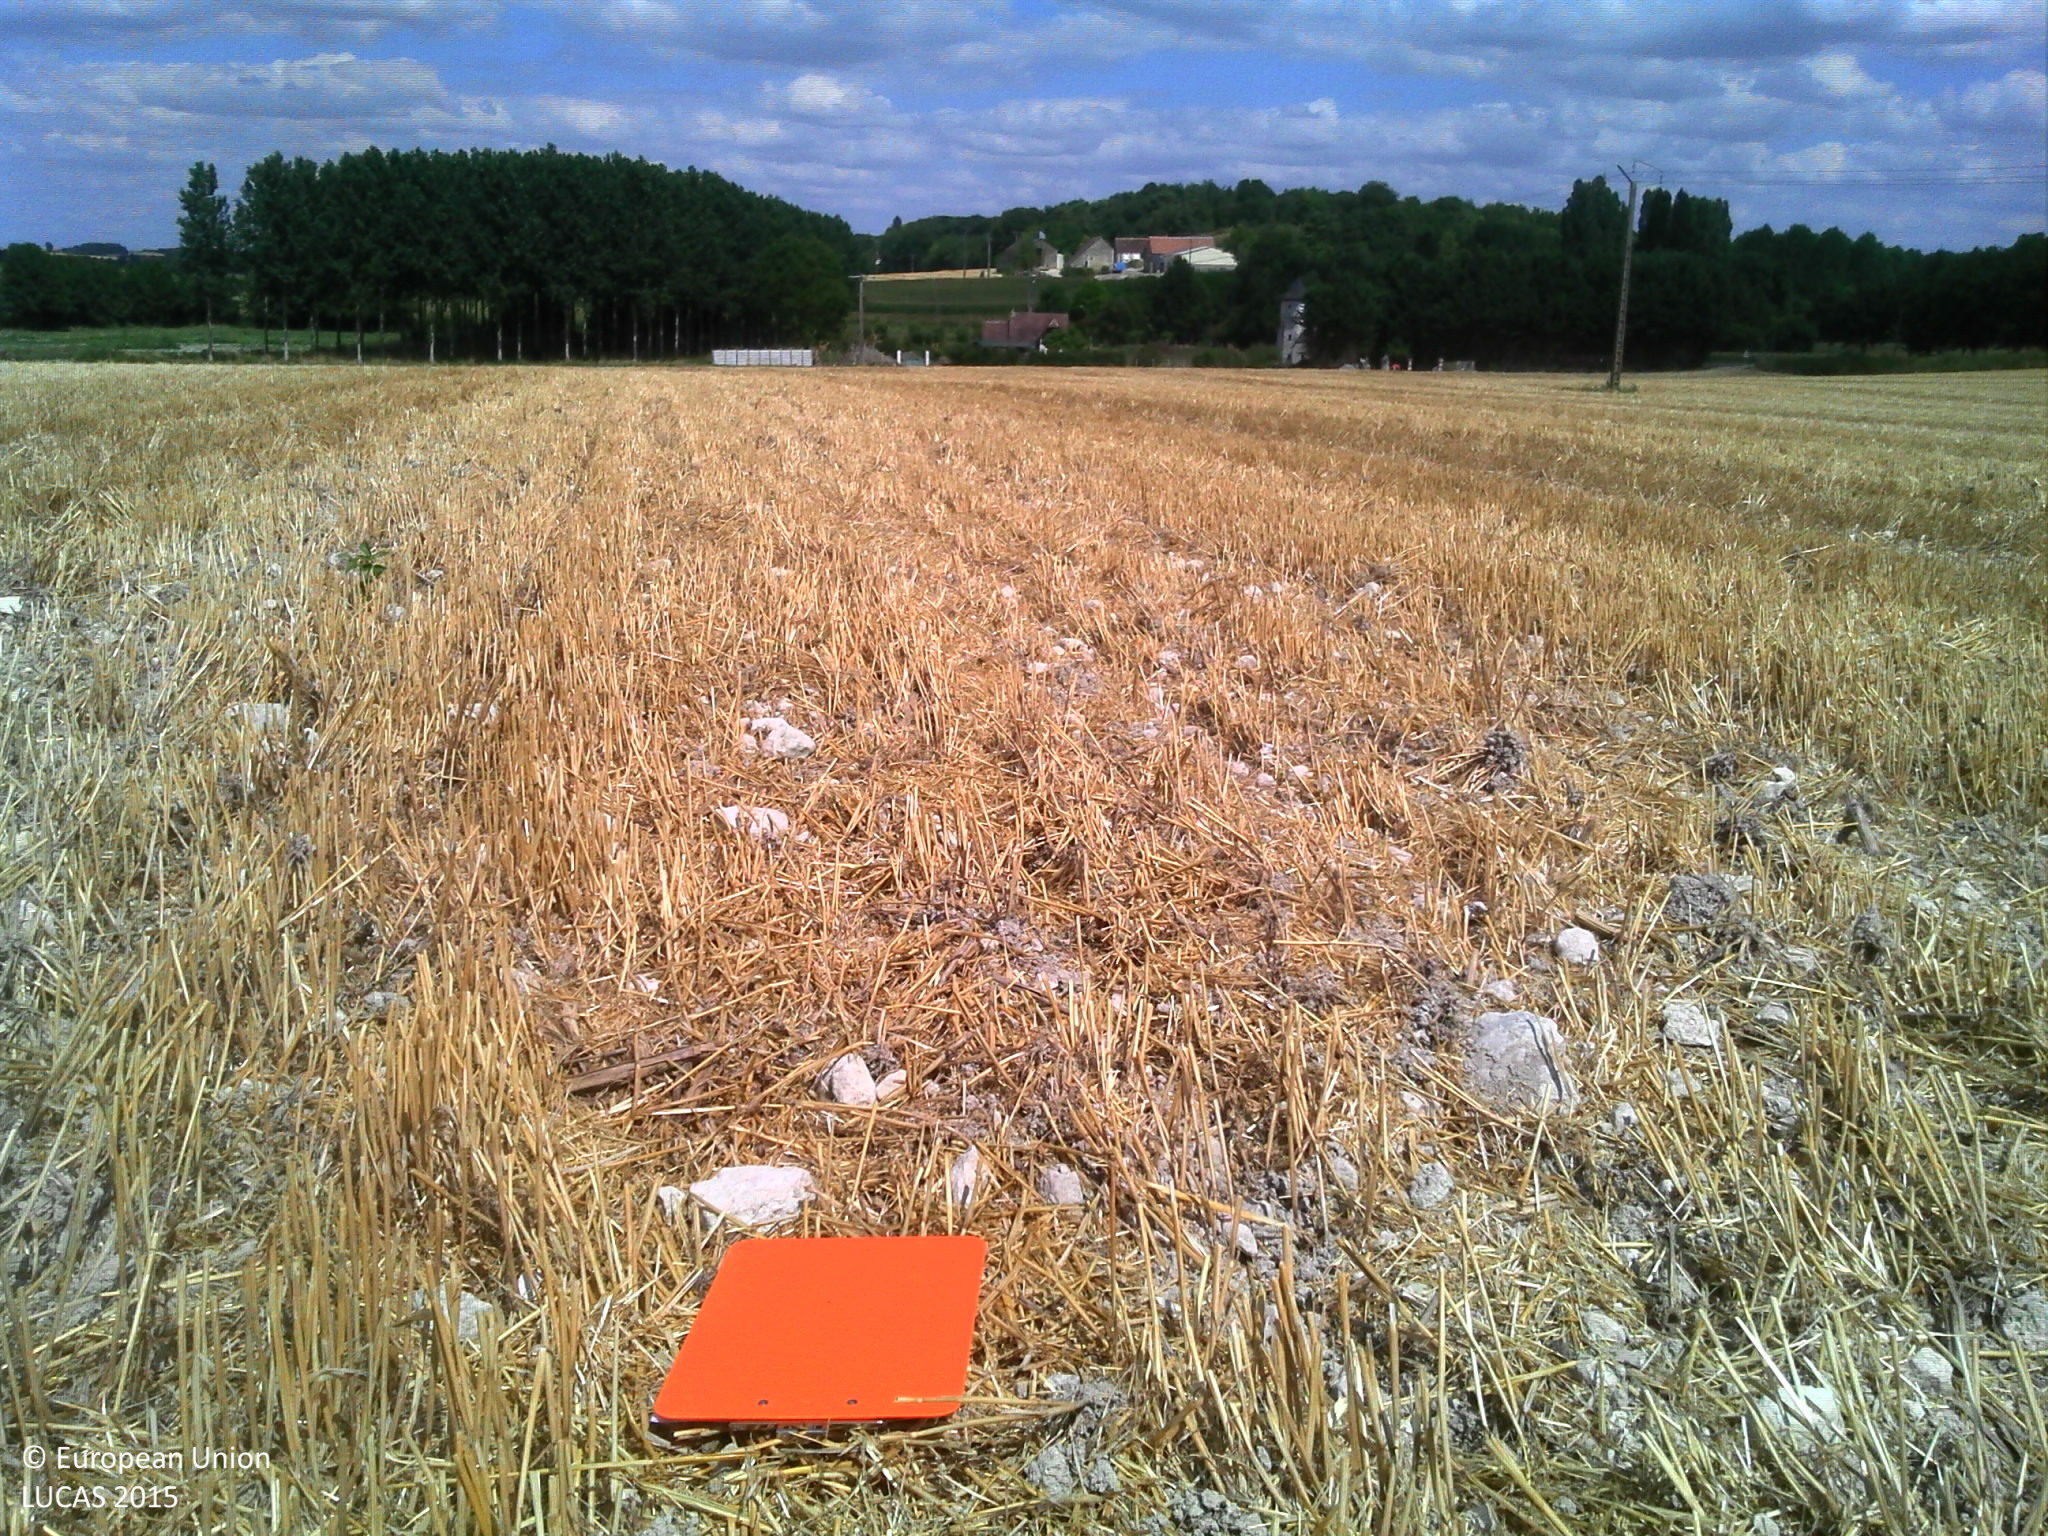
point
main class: Cropland
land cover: Common wheat
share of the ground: > 75 %
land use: Agriculture (excluding fallow land and kitchen gardens)
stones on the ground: > 50 %
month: July
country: FR
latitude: 47.0464
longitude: 0.8616
